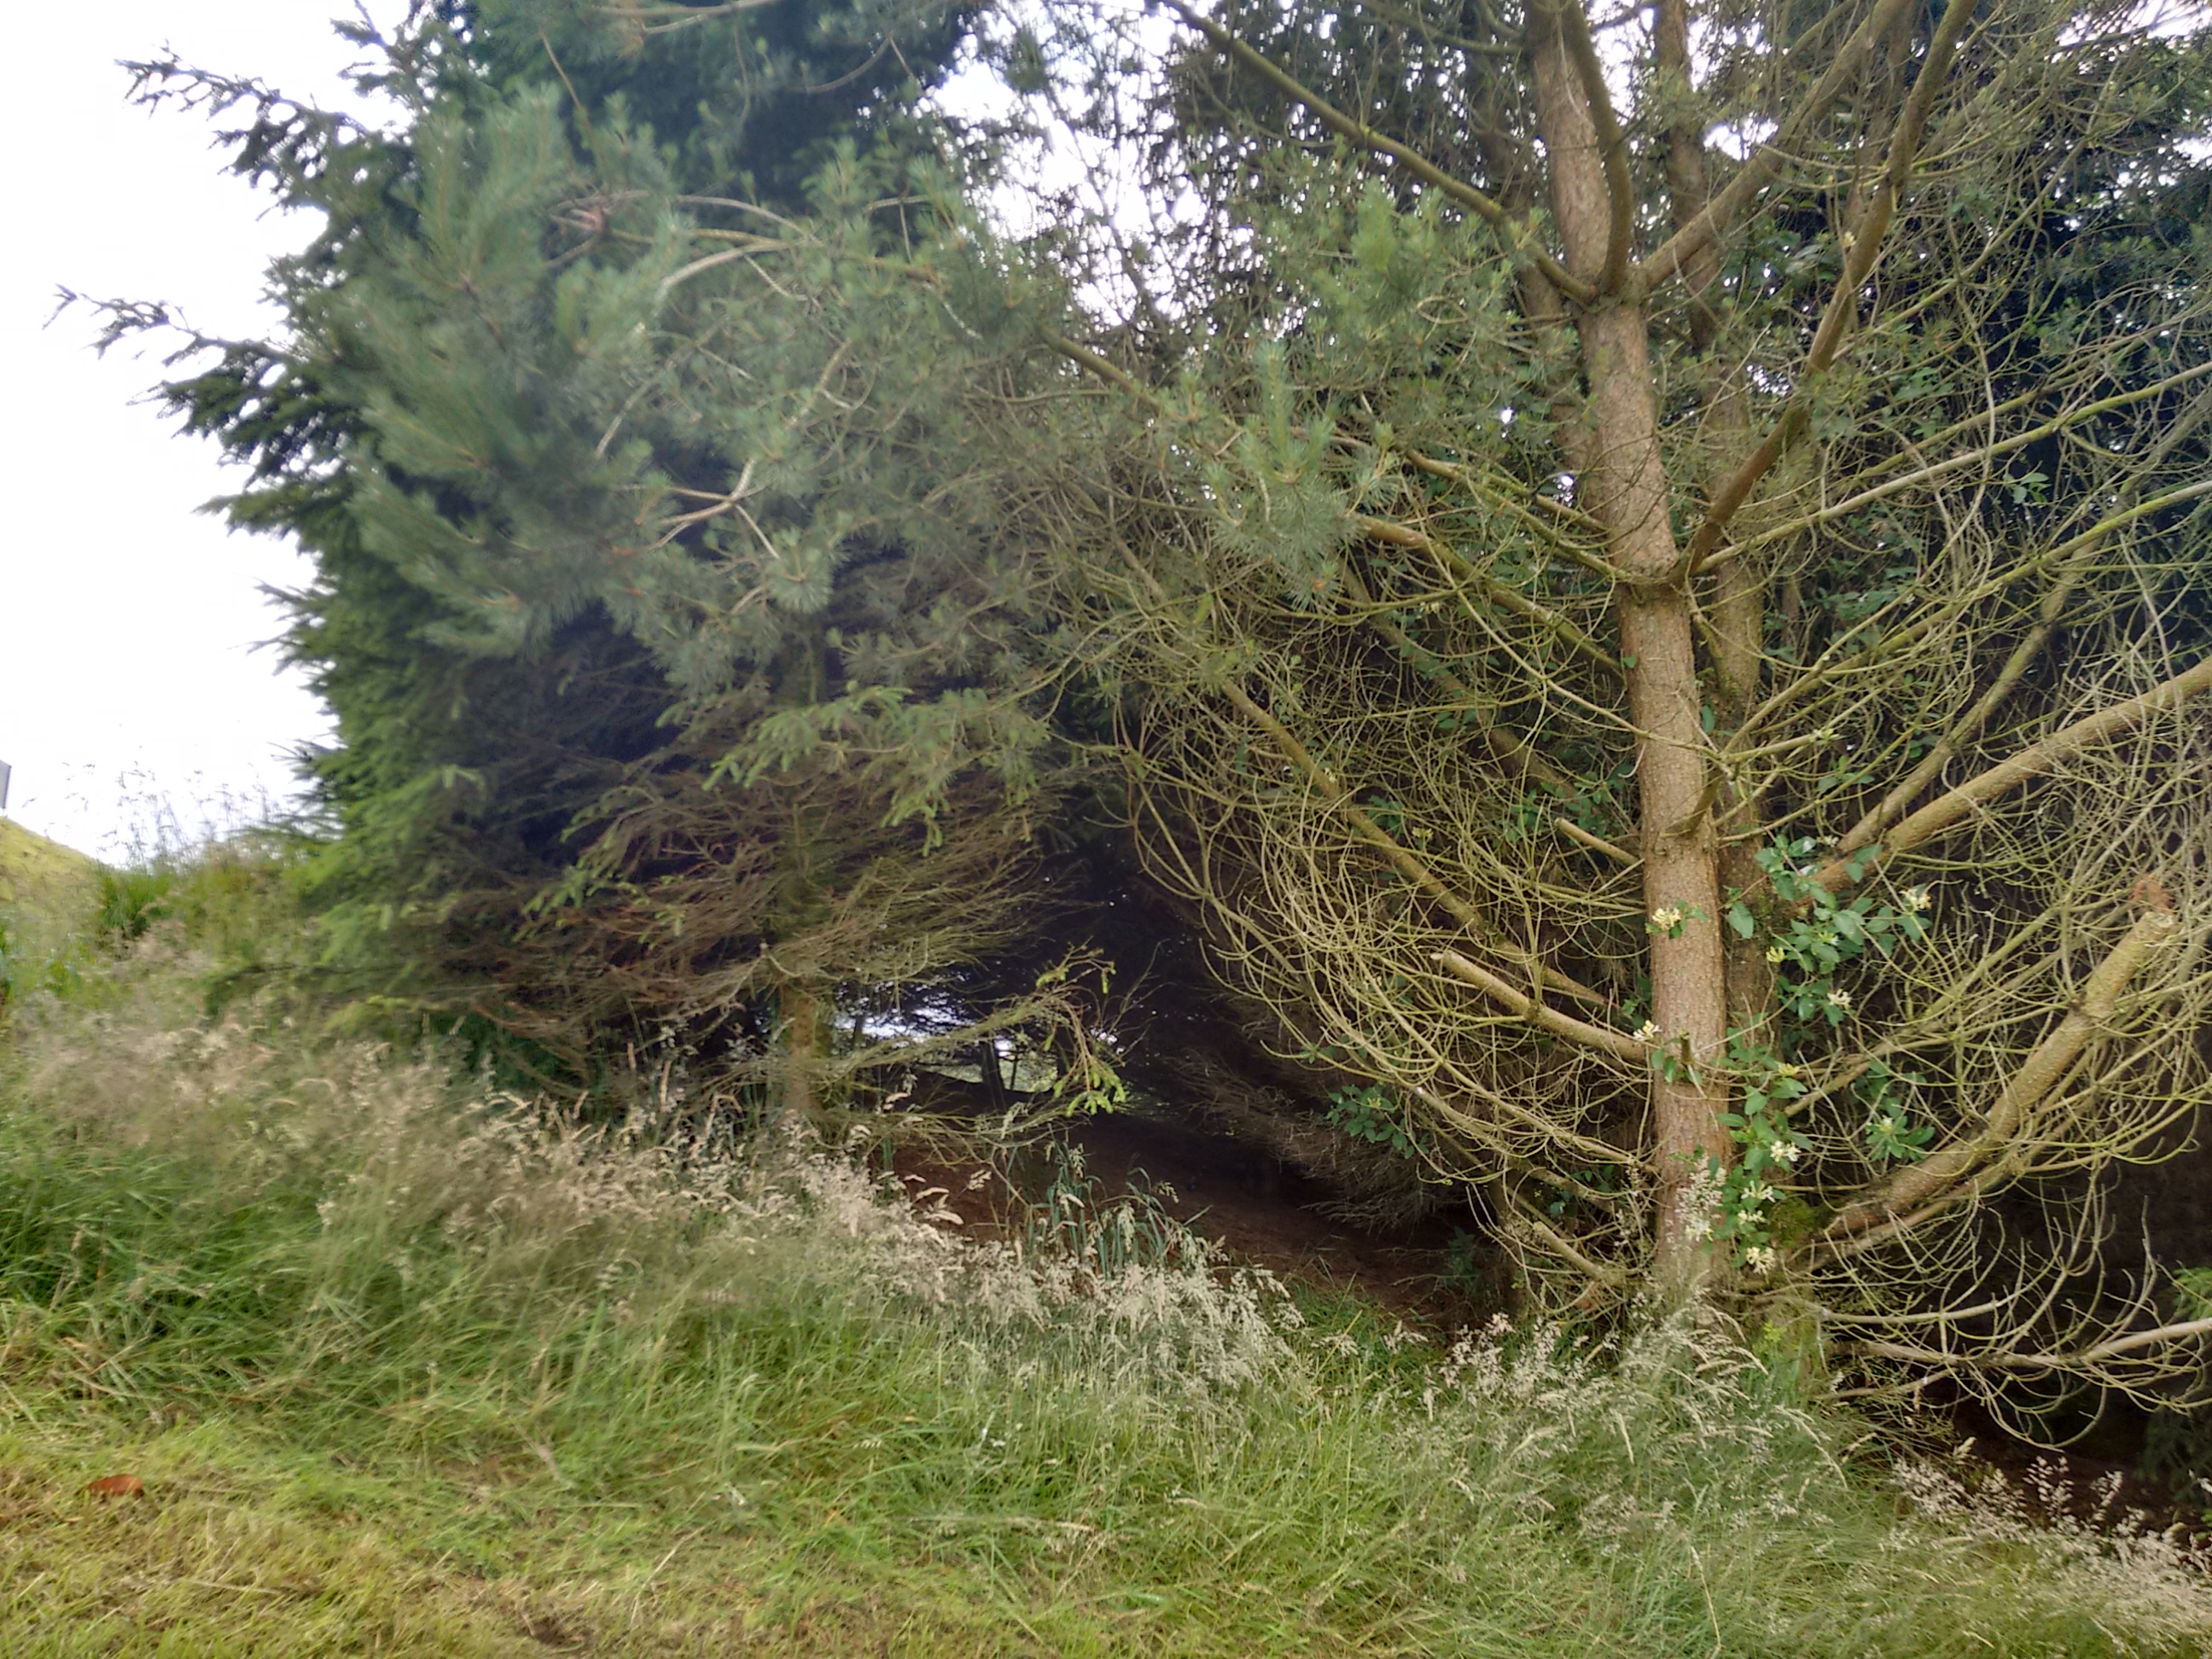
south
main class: Grassland
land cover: Grassland with sparse tree/shrub cover
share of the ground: > 75 %
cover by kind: herbaceous plants 95 %, coniferous forest trees 5 %
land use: Sport
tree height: > 5 m
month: July
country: GB
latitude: 54.3657
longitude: -7.3426
